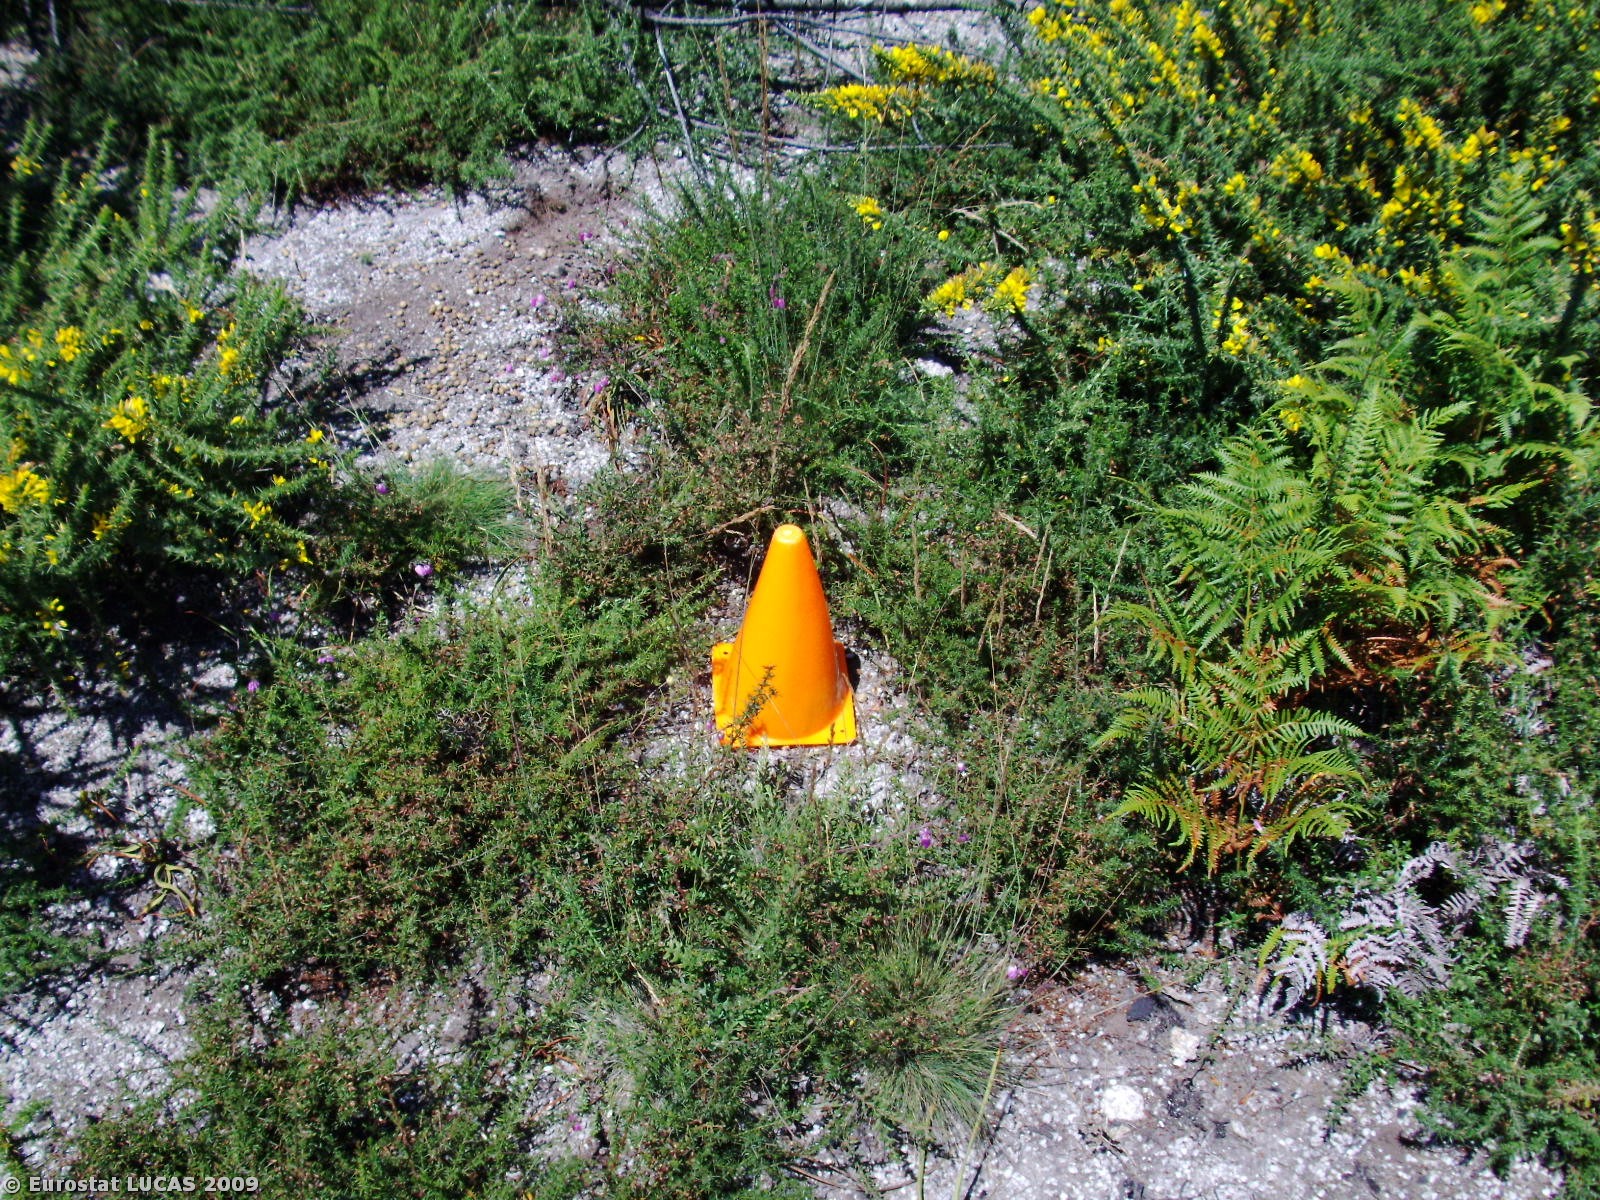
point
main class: Shrubland
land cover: Shrubland without tree cover
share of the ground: > 75 %
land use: Unused
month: July
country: PT
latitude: 41.5834
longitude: -8.7688
